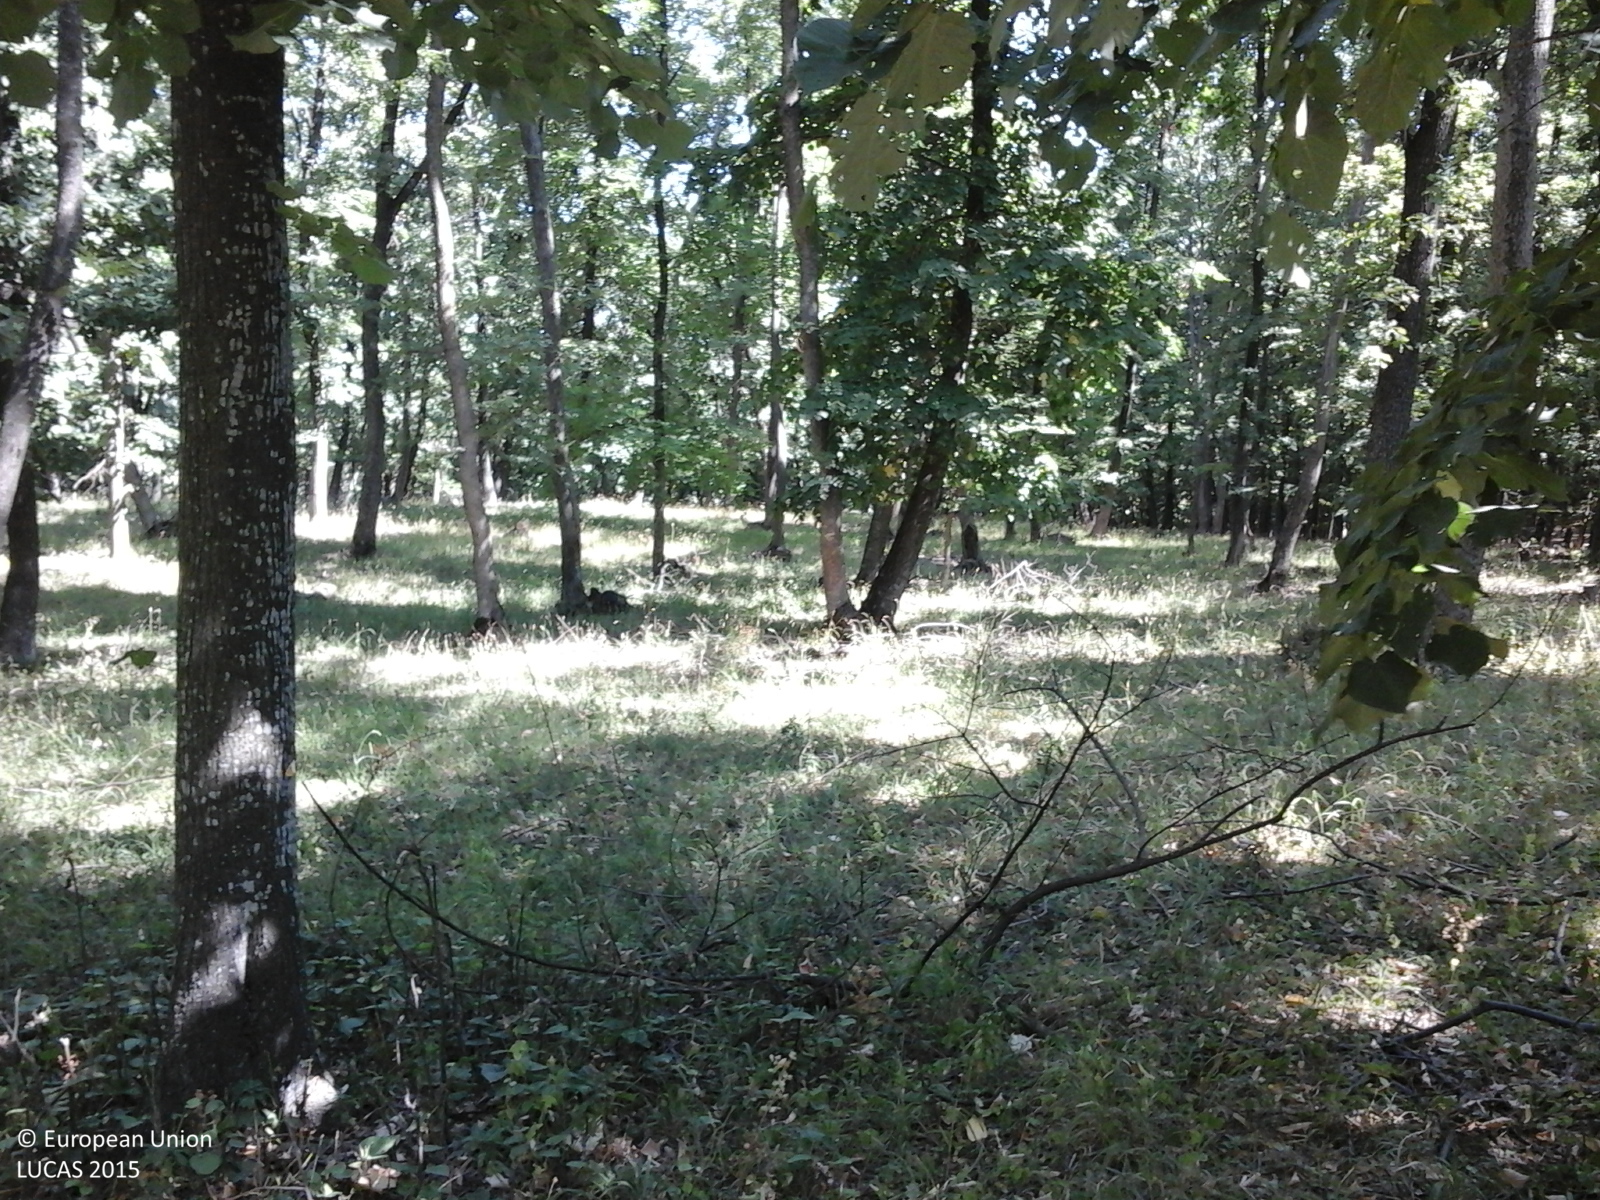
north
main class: Woodland
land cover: Broadleaved woodland
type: mesophytic deciduous forest
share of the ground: > 75 %
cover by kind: broadleaved forest trees 100 %
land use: Forestry
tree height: > 5 m
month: July
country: RO
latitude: 45.9999
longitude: 27.7128
